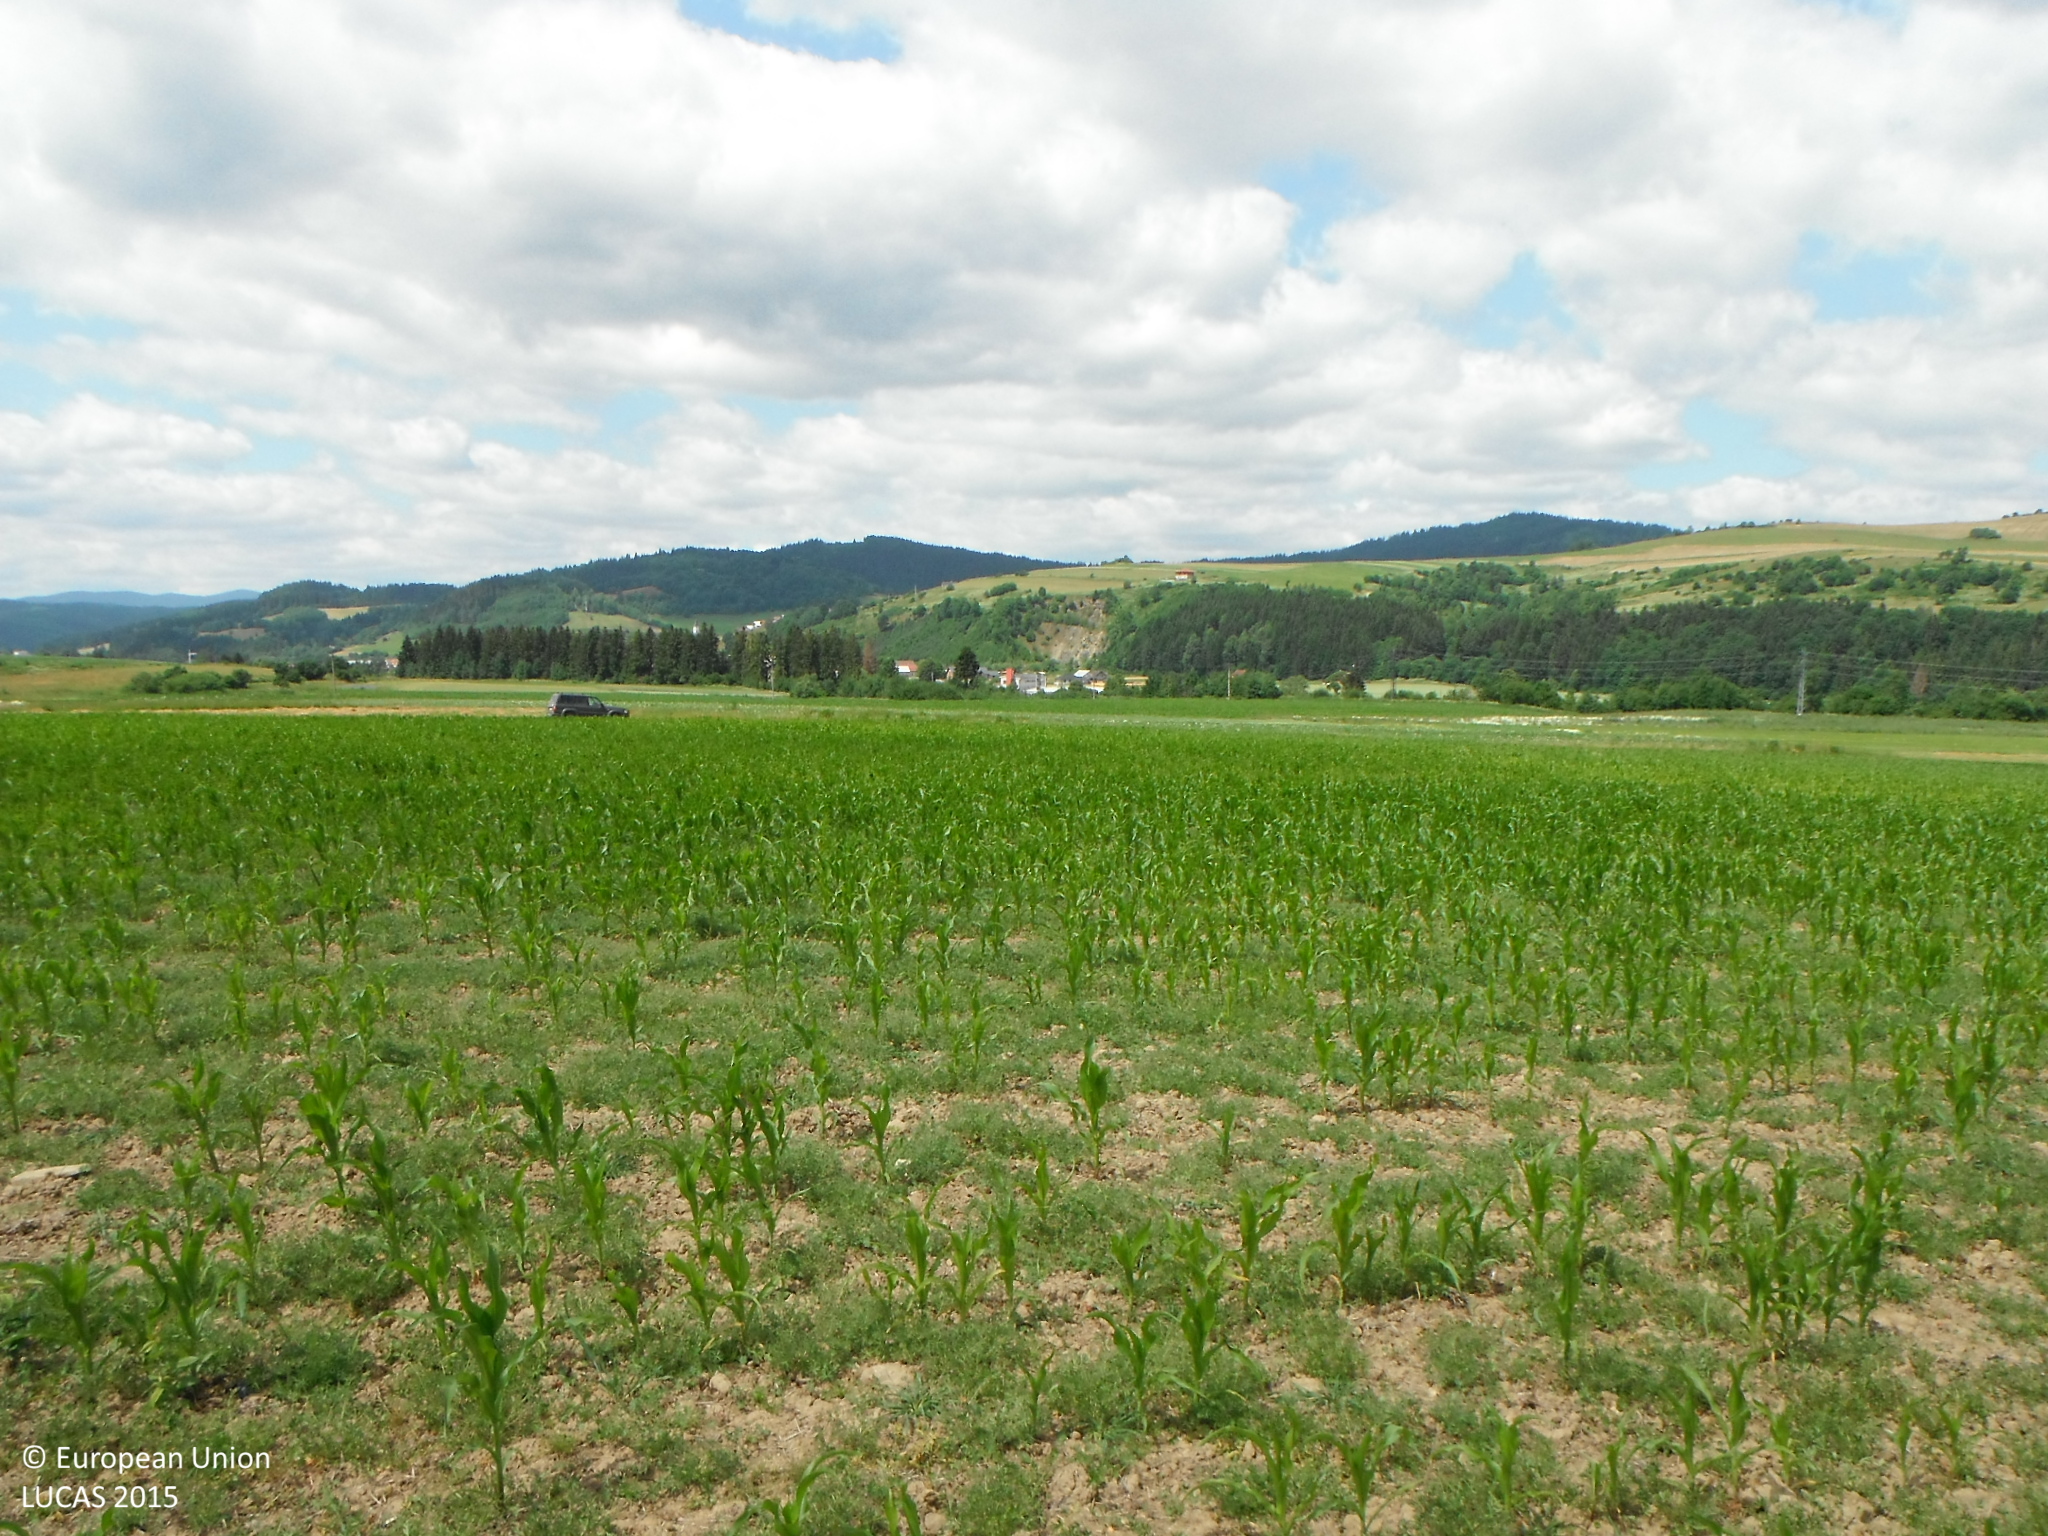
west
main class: Cropland
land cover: Maize
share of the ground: 25 - 50 %
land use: Agriculture (excluding fallow land and kitchen gardens)
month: July
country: SK
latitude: 49.3914
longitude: 19.4637
